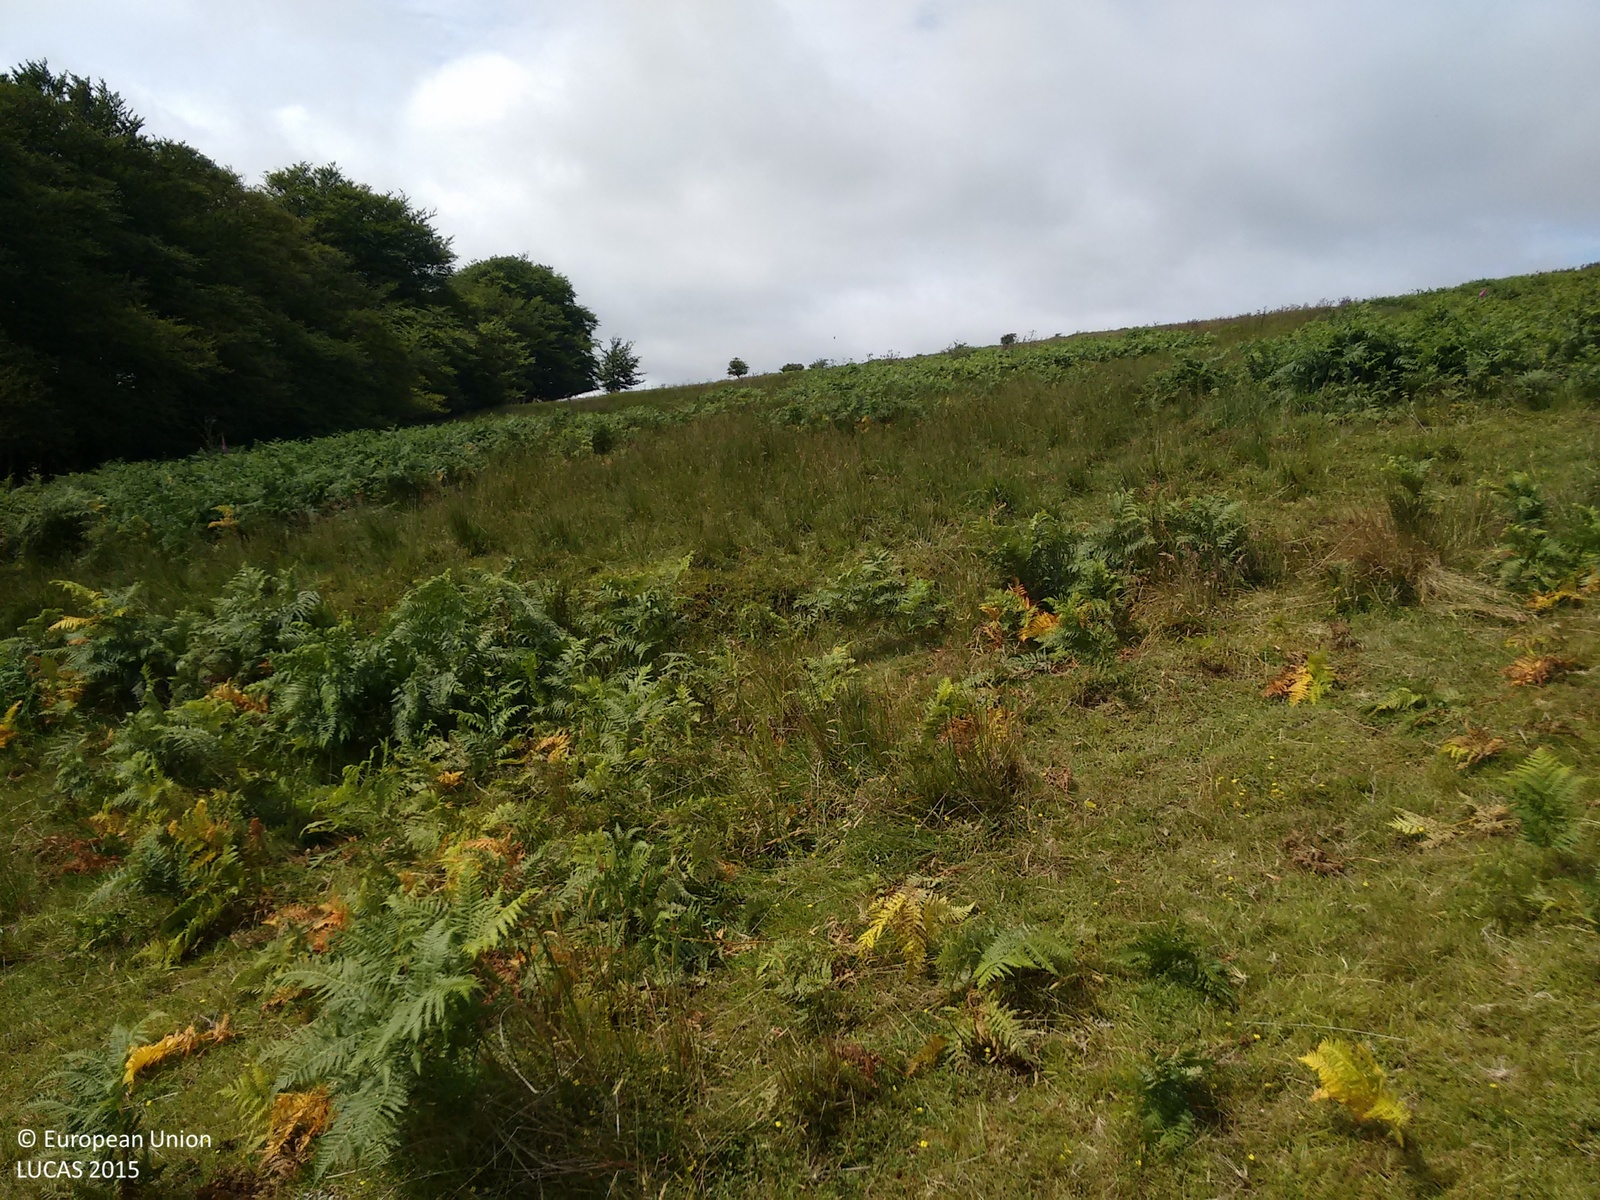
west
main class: Grassland
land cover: Grassland without tree/shrub cover
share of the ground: > 75 %
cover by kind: herbaceous plants 100 %
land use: Agriculture (excluding fallow land and kitchen gardens)
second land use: Amenities, museums, leisure
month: July
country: GB
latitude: 51.1558
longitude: -3.5684
